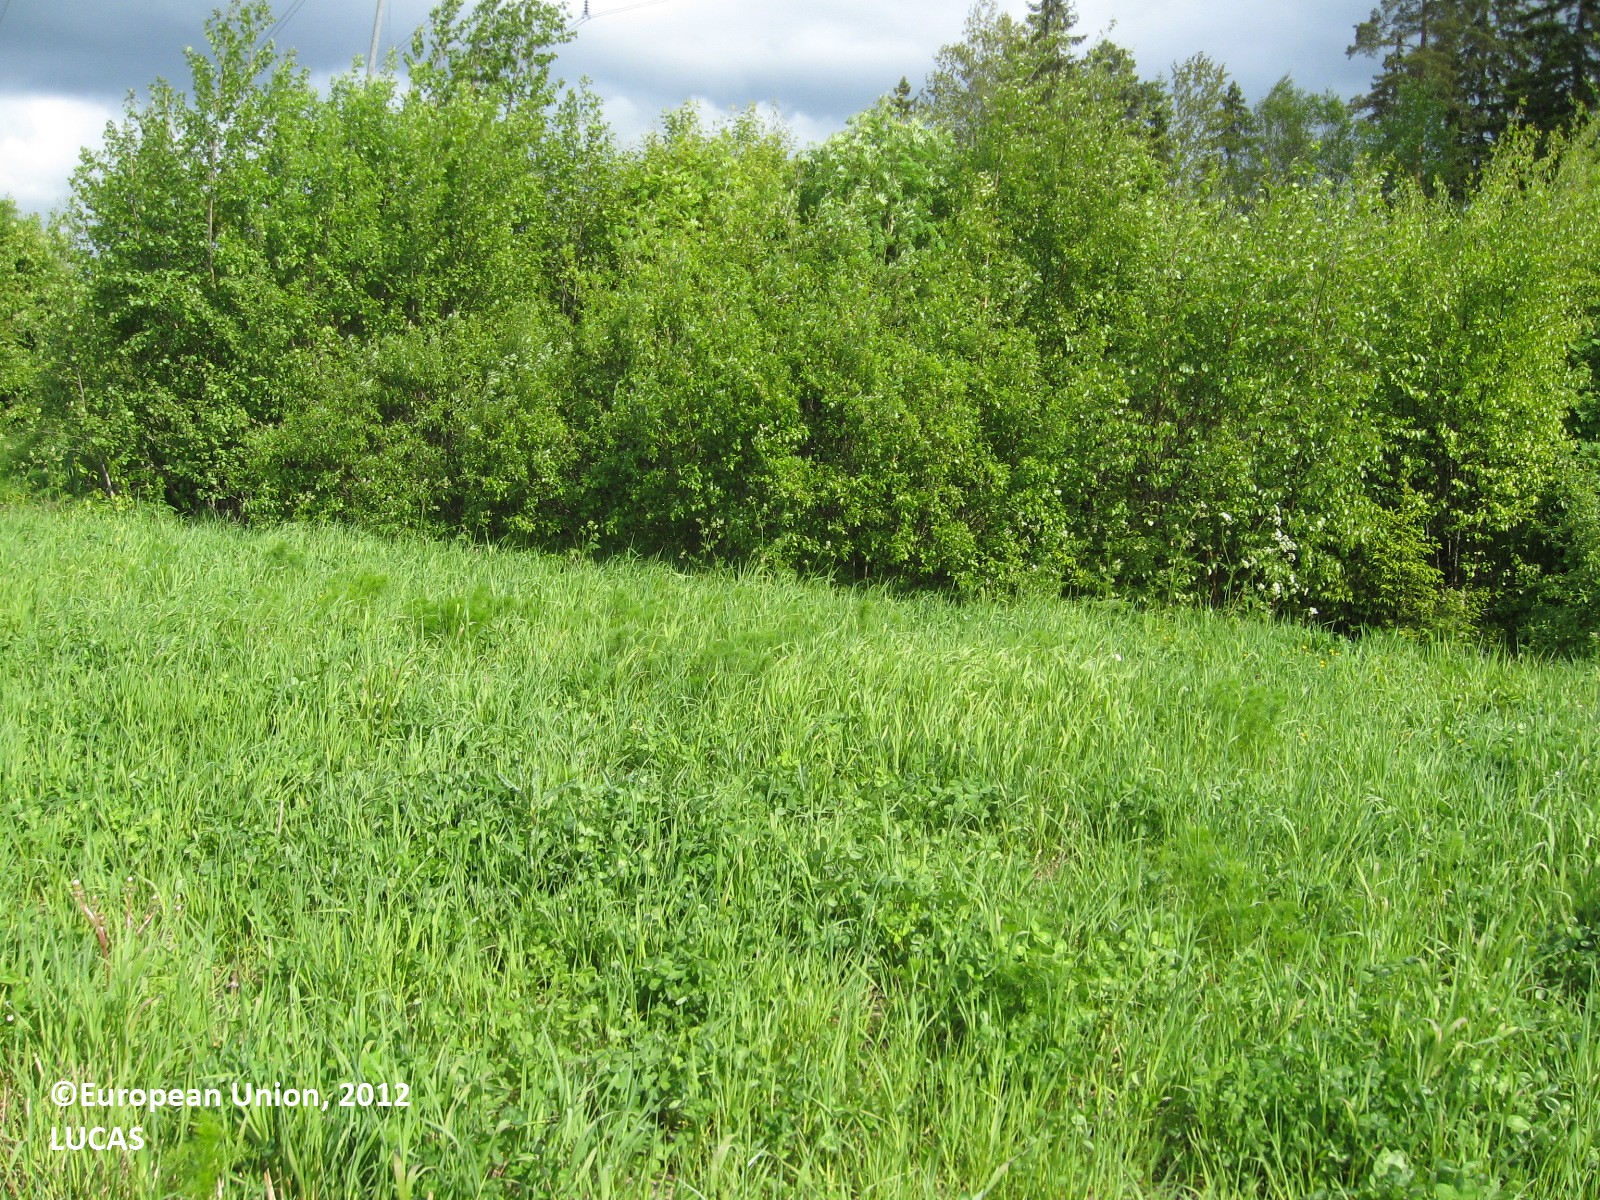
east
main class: Grassland
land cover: Grassland without tree/shrub cover
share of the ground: > 75 %
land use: Agriculture (excluding fallow land and kitchen gardens)
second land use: Energy production
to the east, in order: Grassland without tree/shrub cover; Electric lines; Ditches and canals; Broadleaved woodland; Electric lines; Broadleaved woodland; Pine dominated mixed woodland; Broadleaved woodland; Electric lines; Ditches and canals; Paved roads, cycling and walking lanes; Ditches and canals; Pine dominated mixed woodland; Spruce dominated mixed woodland; Temporary grasslands; Spruce dominated mixed woodland; Temporary grasslands
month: June
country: FI
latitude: 63.0709
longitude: 21.8986
